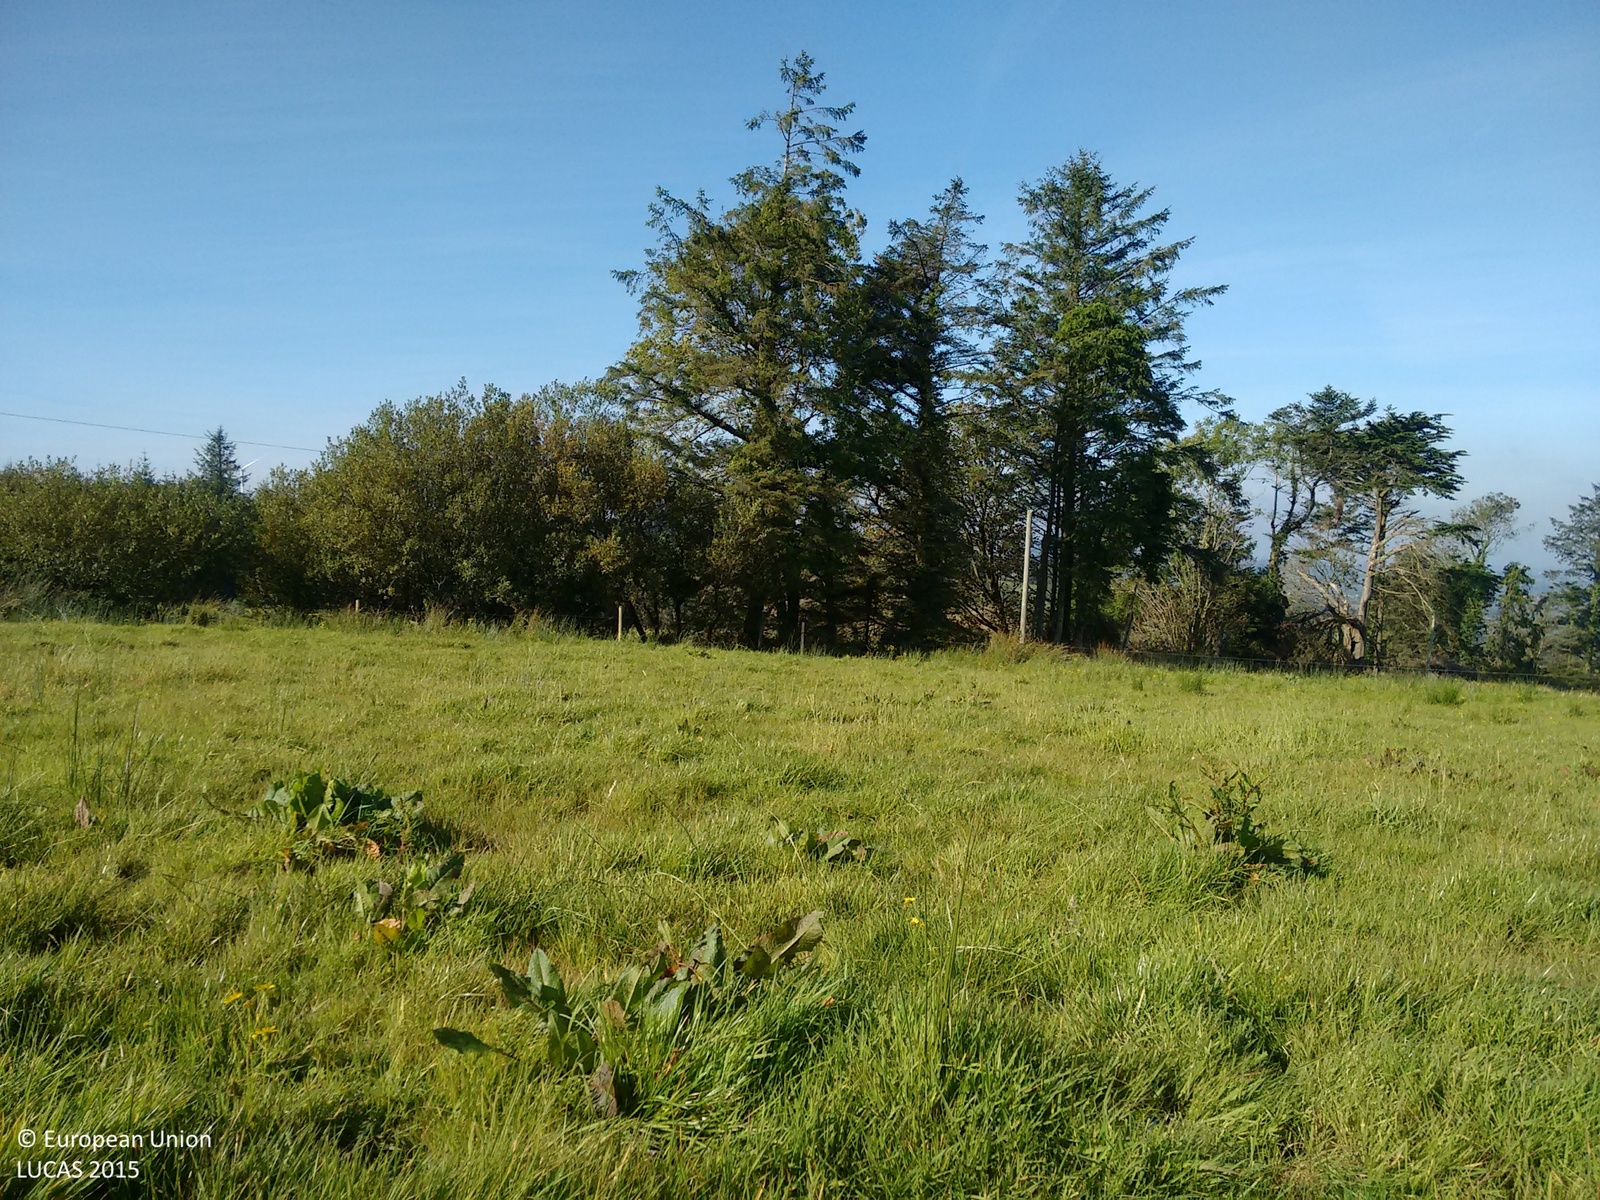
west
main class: Grassland
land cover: Grassland without tree/shrub cover
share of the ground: > 75 %
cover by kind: herbaceous plants 100 %
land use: Agriculture (excluding fallow land and kitchen gardens)
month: September
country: IE
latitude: 52.4465
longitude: -9.2466
